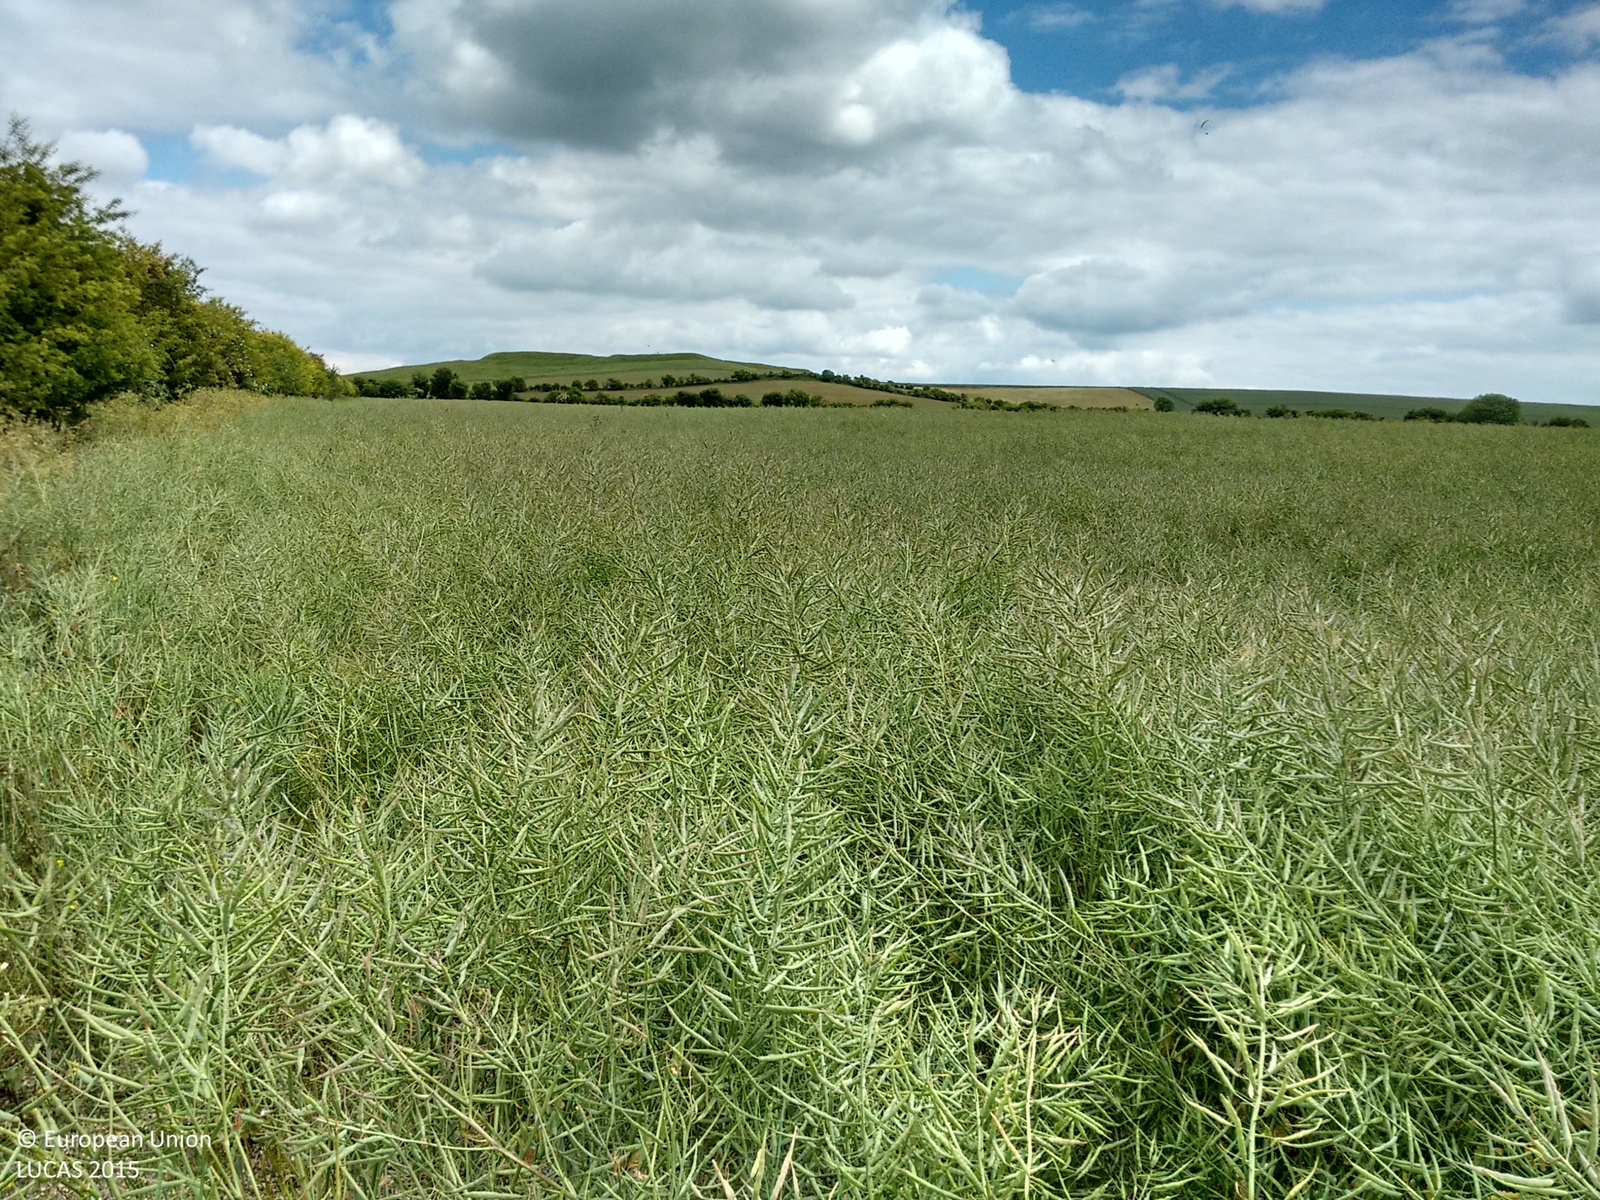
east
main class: Cropland
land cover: Rape and turnip rape
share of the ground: > 75 %
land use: Agriculture (excluding fallow land and kitchen gardens)
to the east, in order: Rape and turnip rape
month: June
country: GB
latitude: 51.5723
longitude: -1.5806
